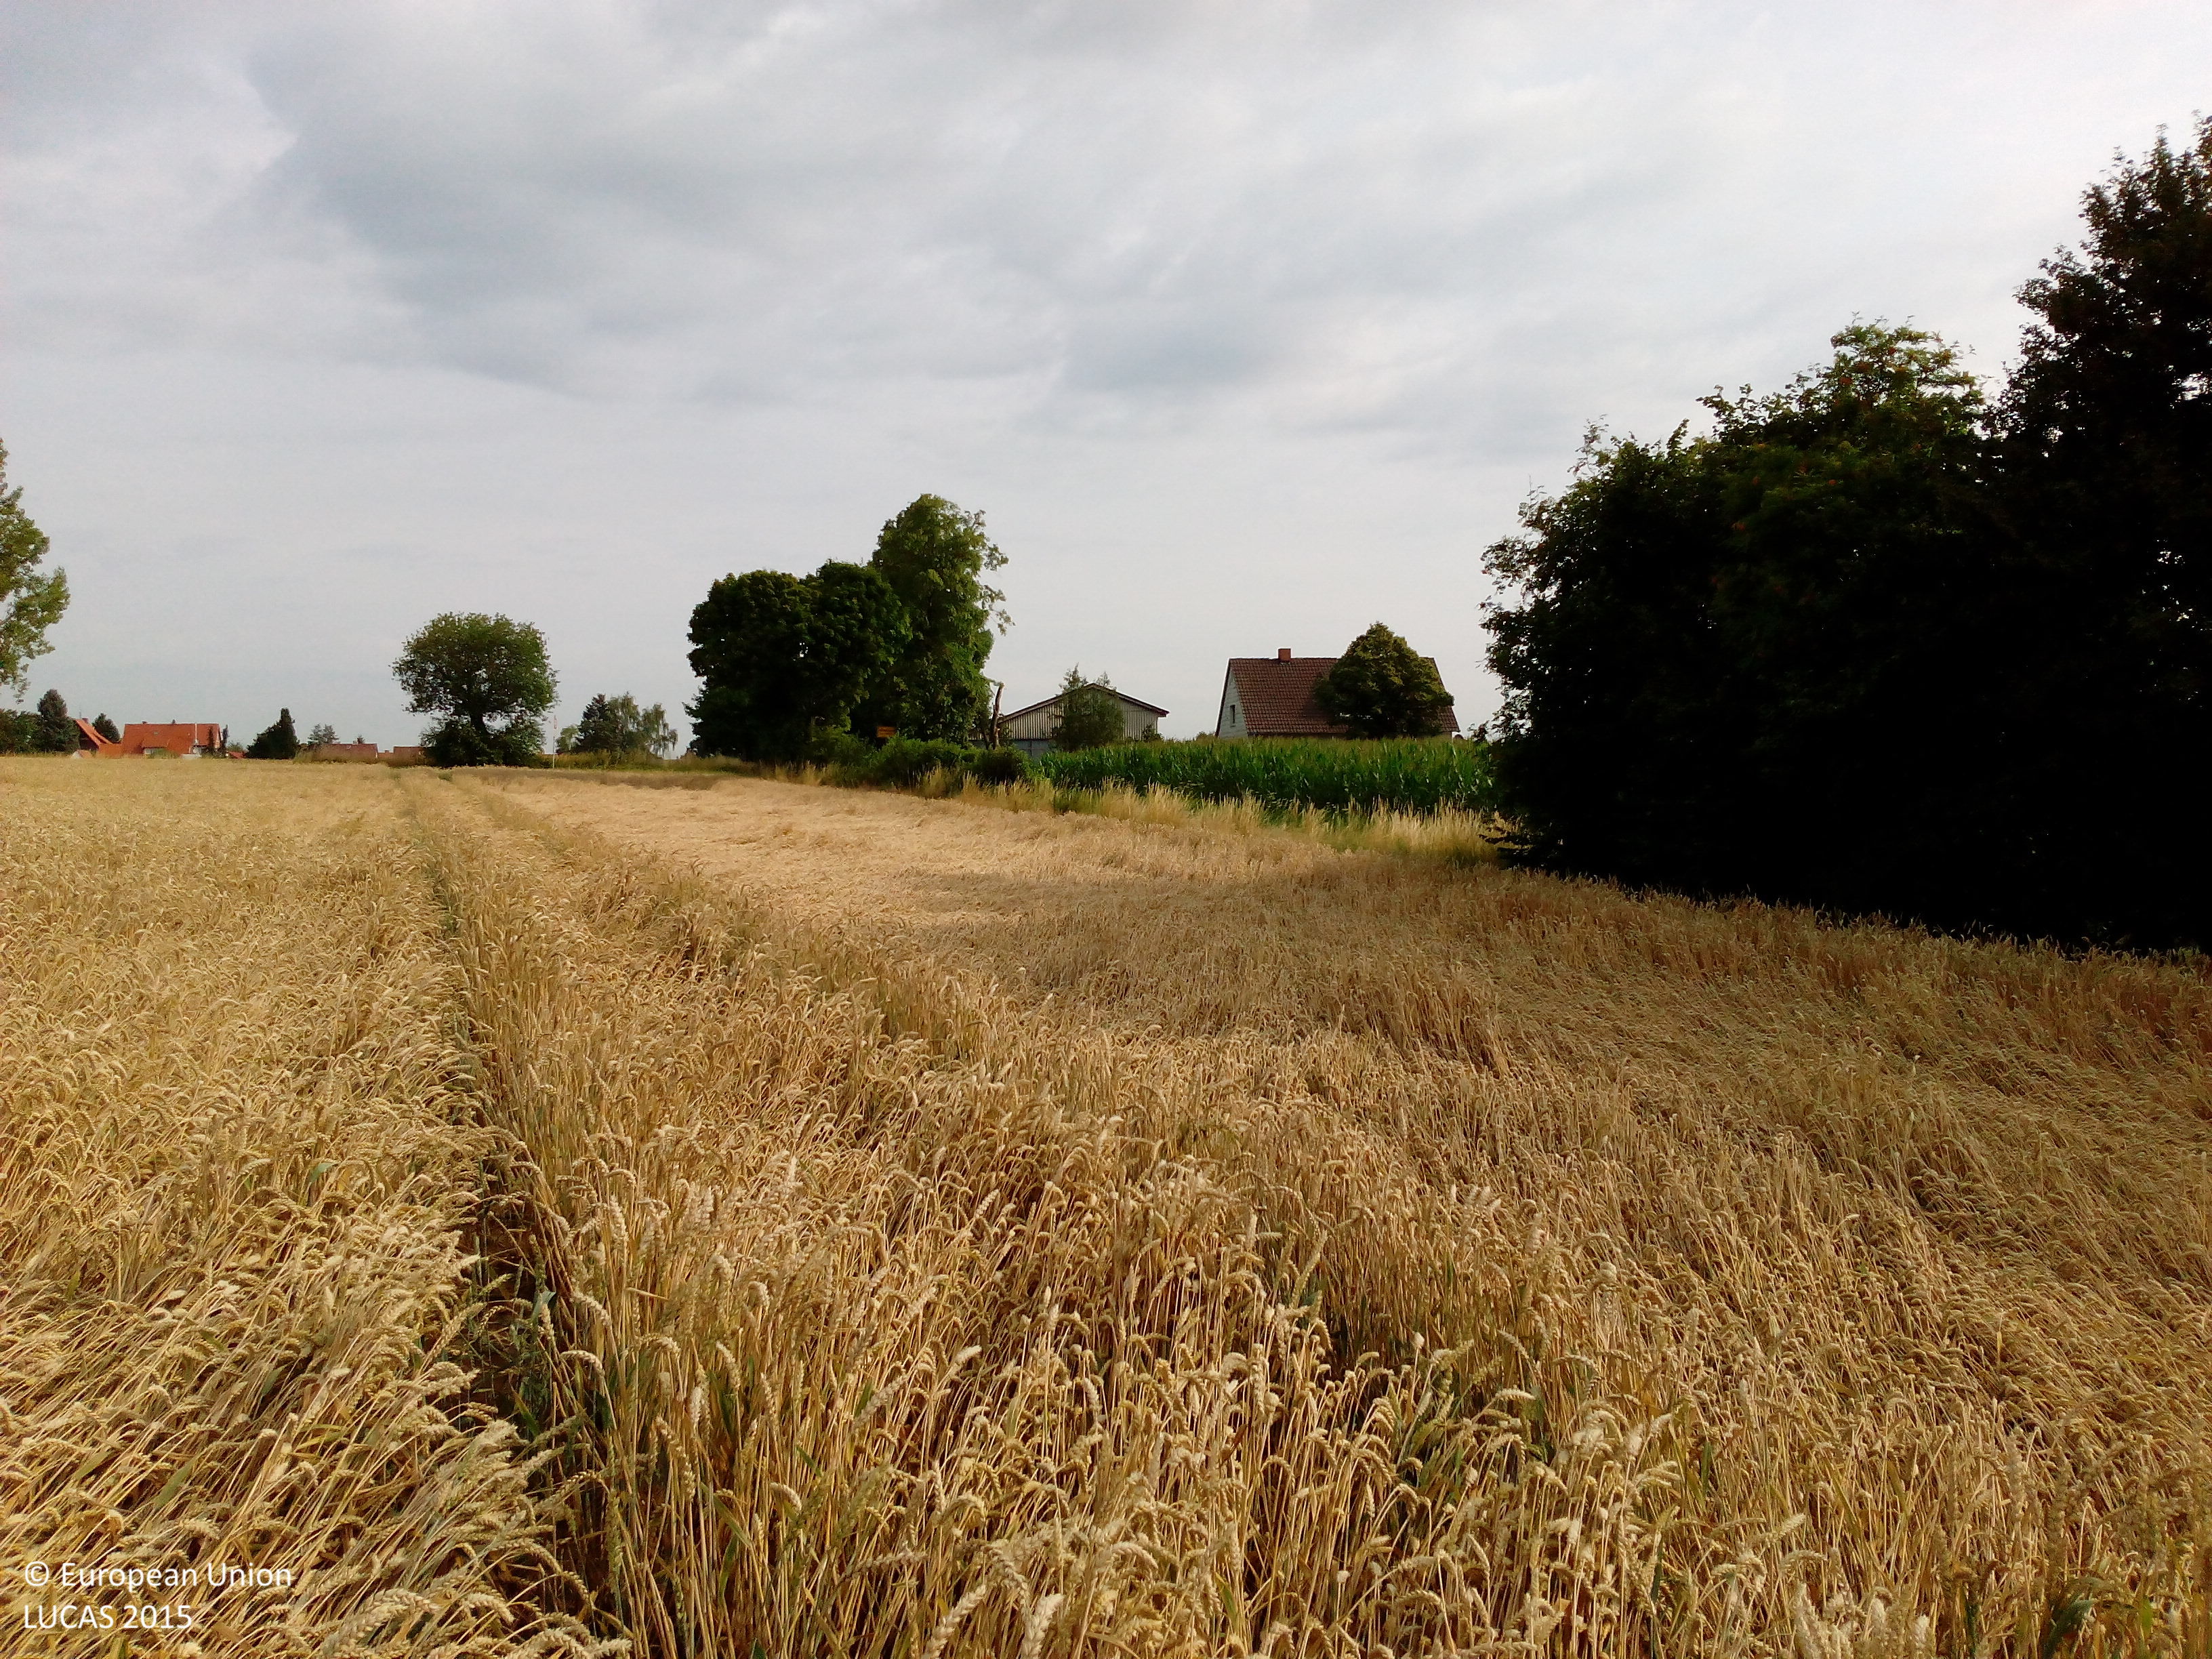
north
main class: Cropland
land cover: Common wheat
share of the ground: > 75 %
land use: Agriculture (excluding fallow land and kitchen gardens)
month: July
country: DE
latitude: 51.5146
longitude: 9.8704
